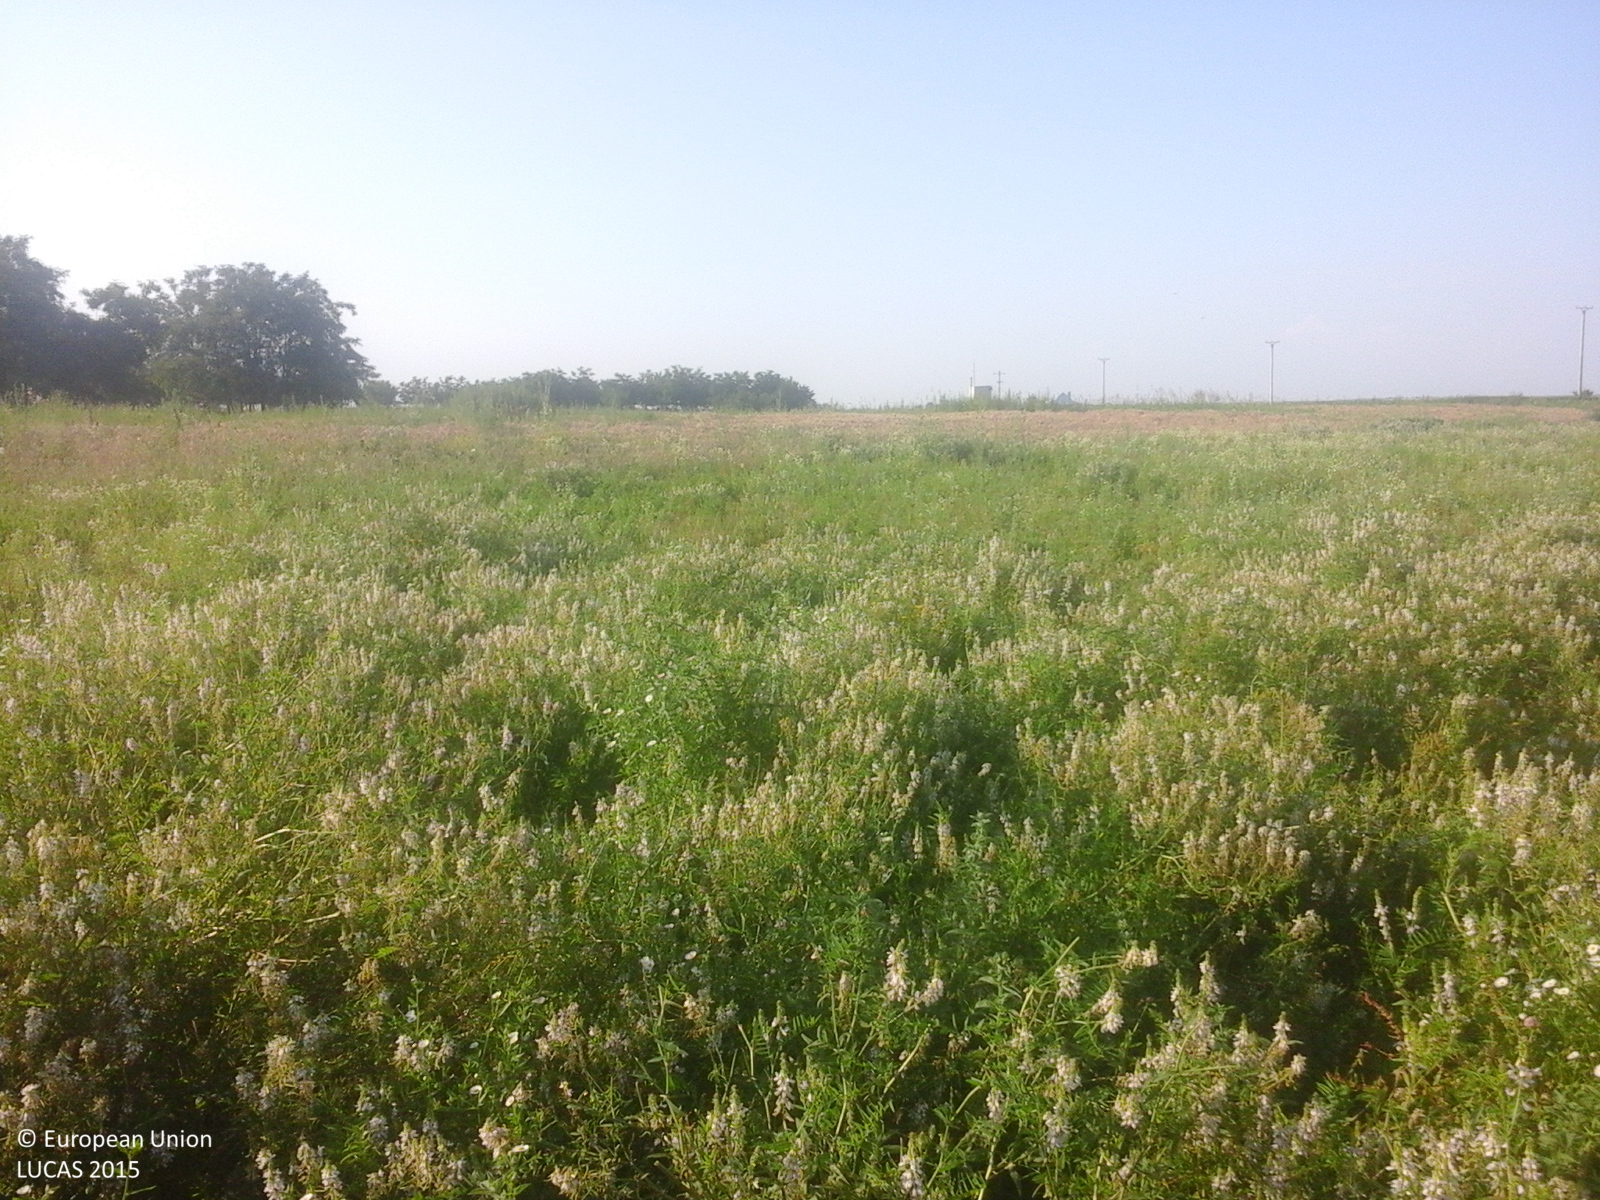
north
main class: Grassland
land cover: Spontaneously vegetated surfaces
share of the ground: > 75 %
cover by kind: herbaceous plants 100 %
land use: Fallow land
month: July
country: RO
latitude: 44.2995
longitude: 24.3426
